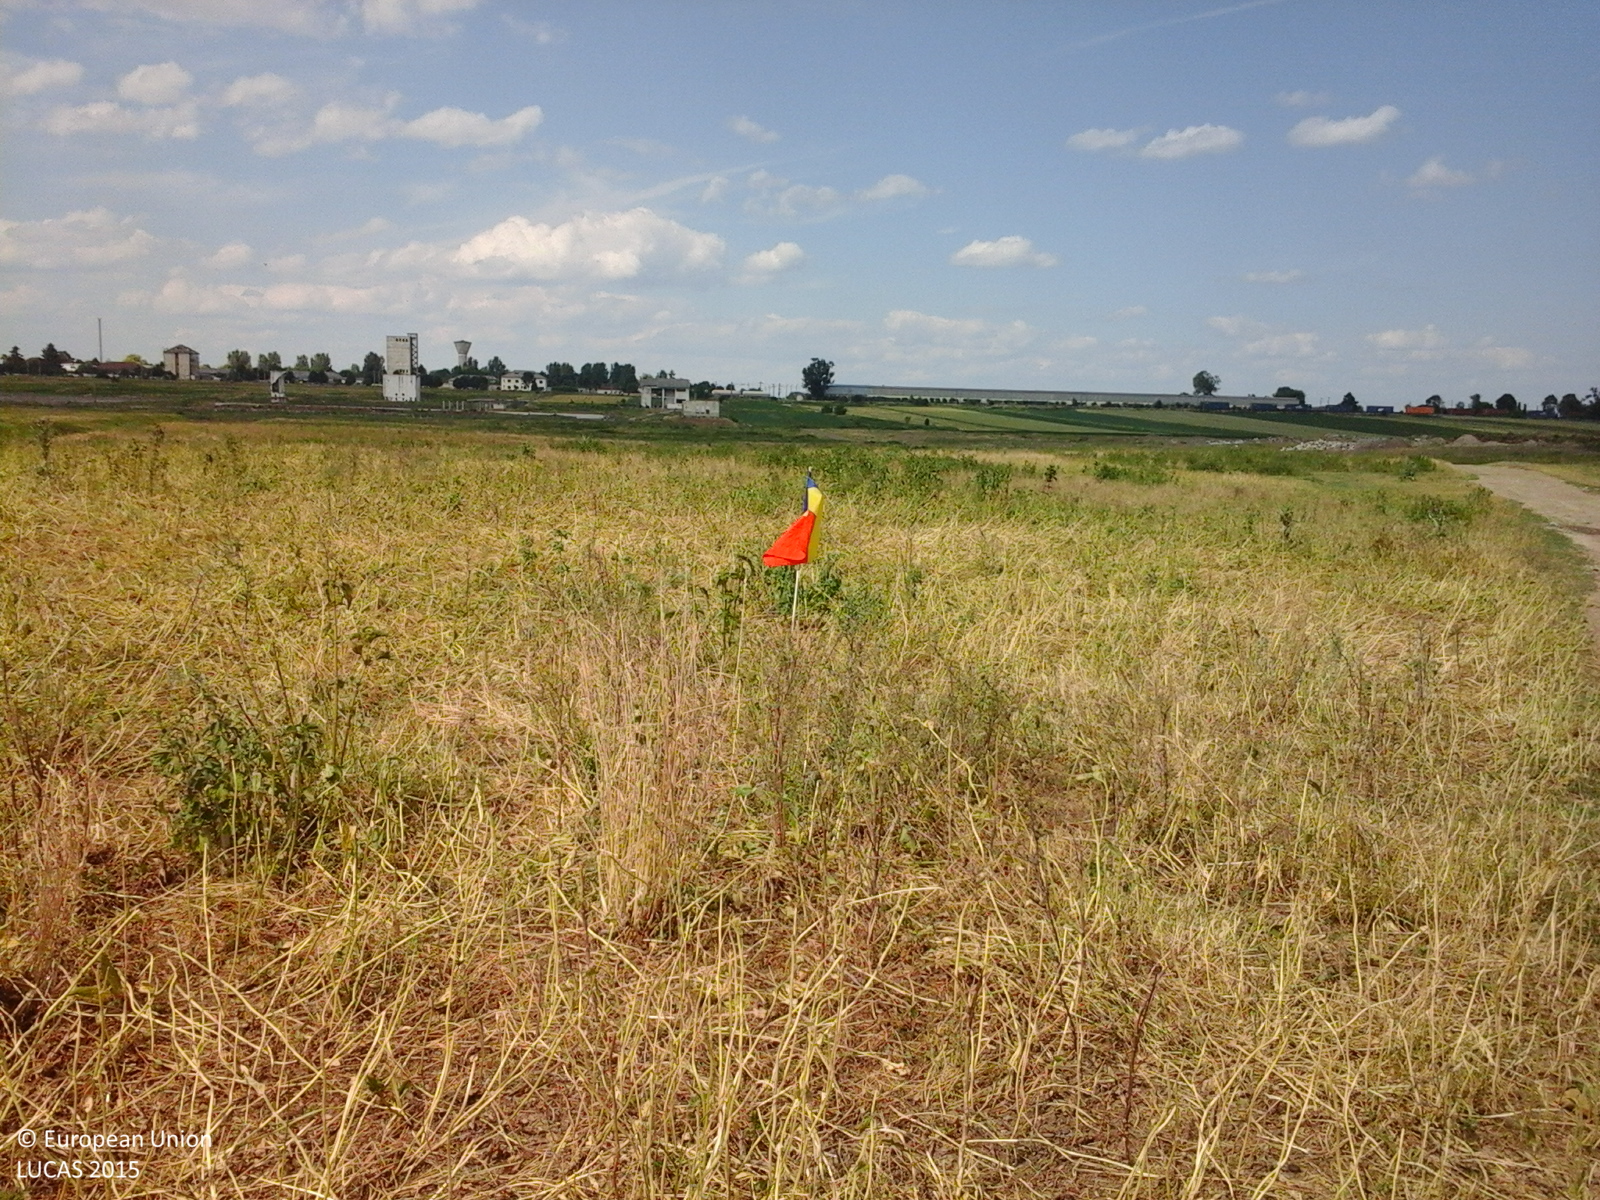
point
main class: Grassland
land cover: Spontaneously vegetated surfaces
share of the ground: > 75 %
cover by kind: herbaceous plants 100 %
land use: Agriculture (excluding fallow land and kitchen gardens)
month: June
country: RO
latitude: 47.6071
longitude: 26.4089
